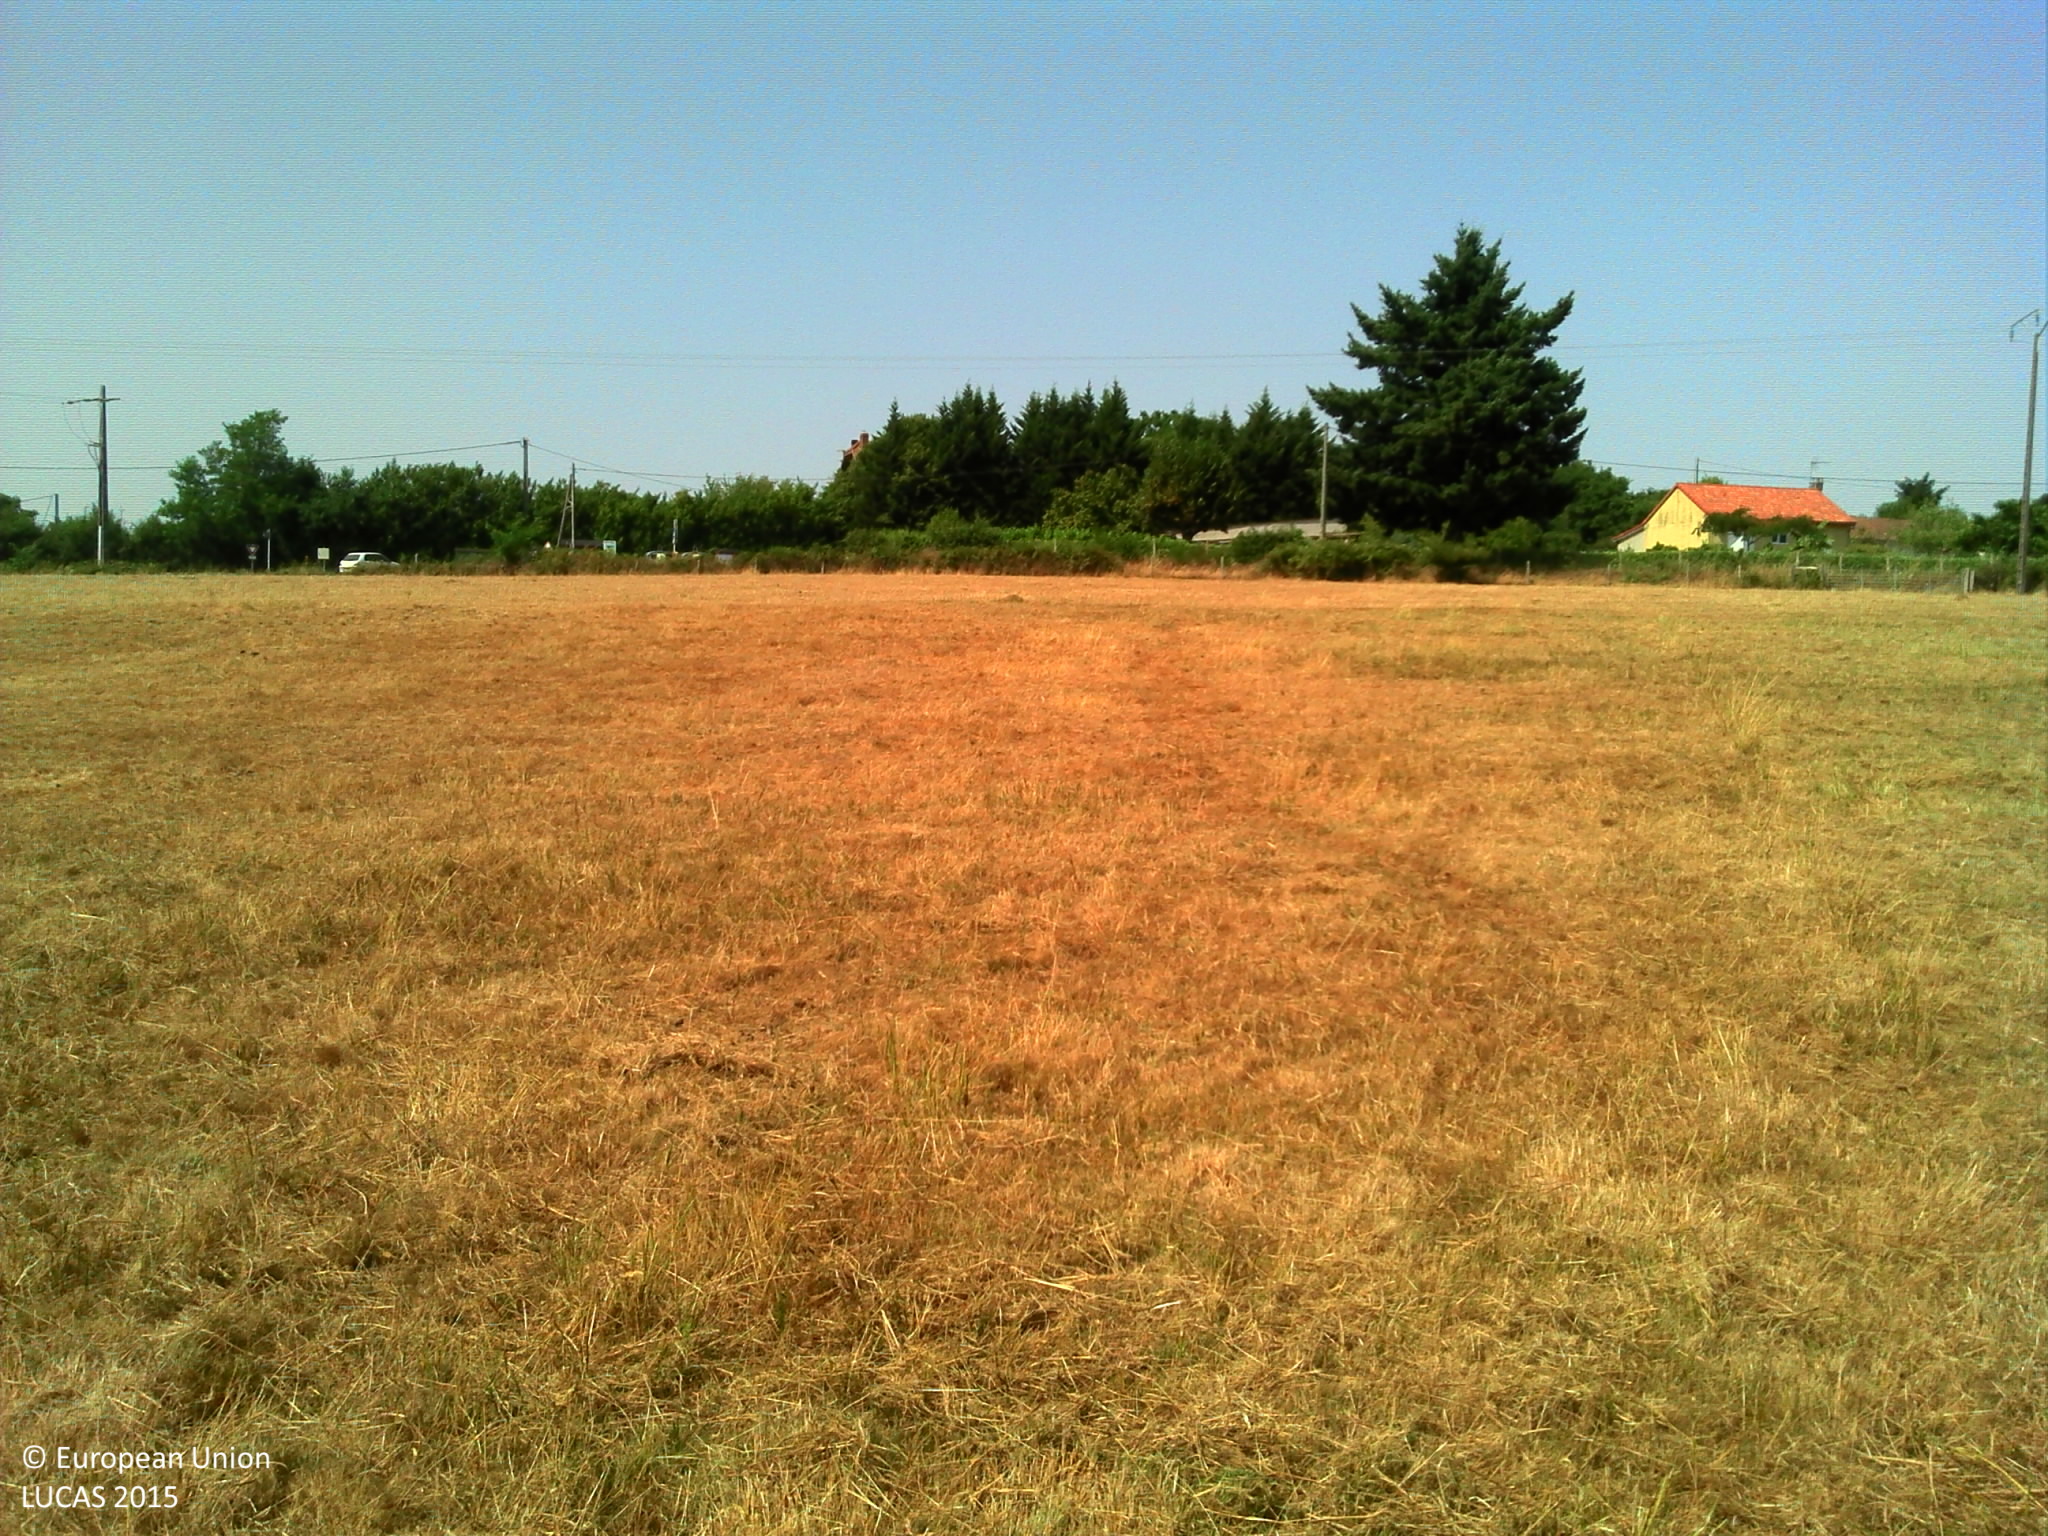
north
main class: Grassland
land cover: Grassland without tree/shrub cover
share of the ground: > 75 %
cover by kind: herbaceous plants 95 %
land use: Agriculture (excluding fallow land and kitchen gardens)
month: July
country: FR
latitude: 45.7719
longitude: 1.0004
